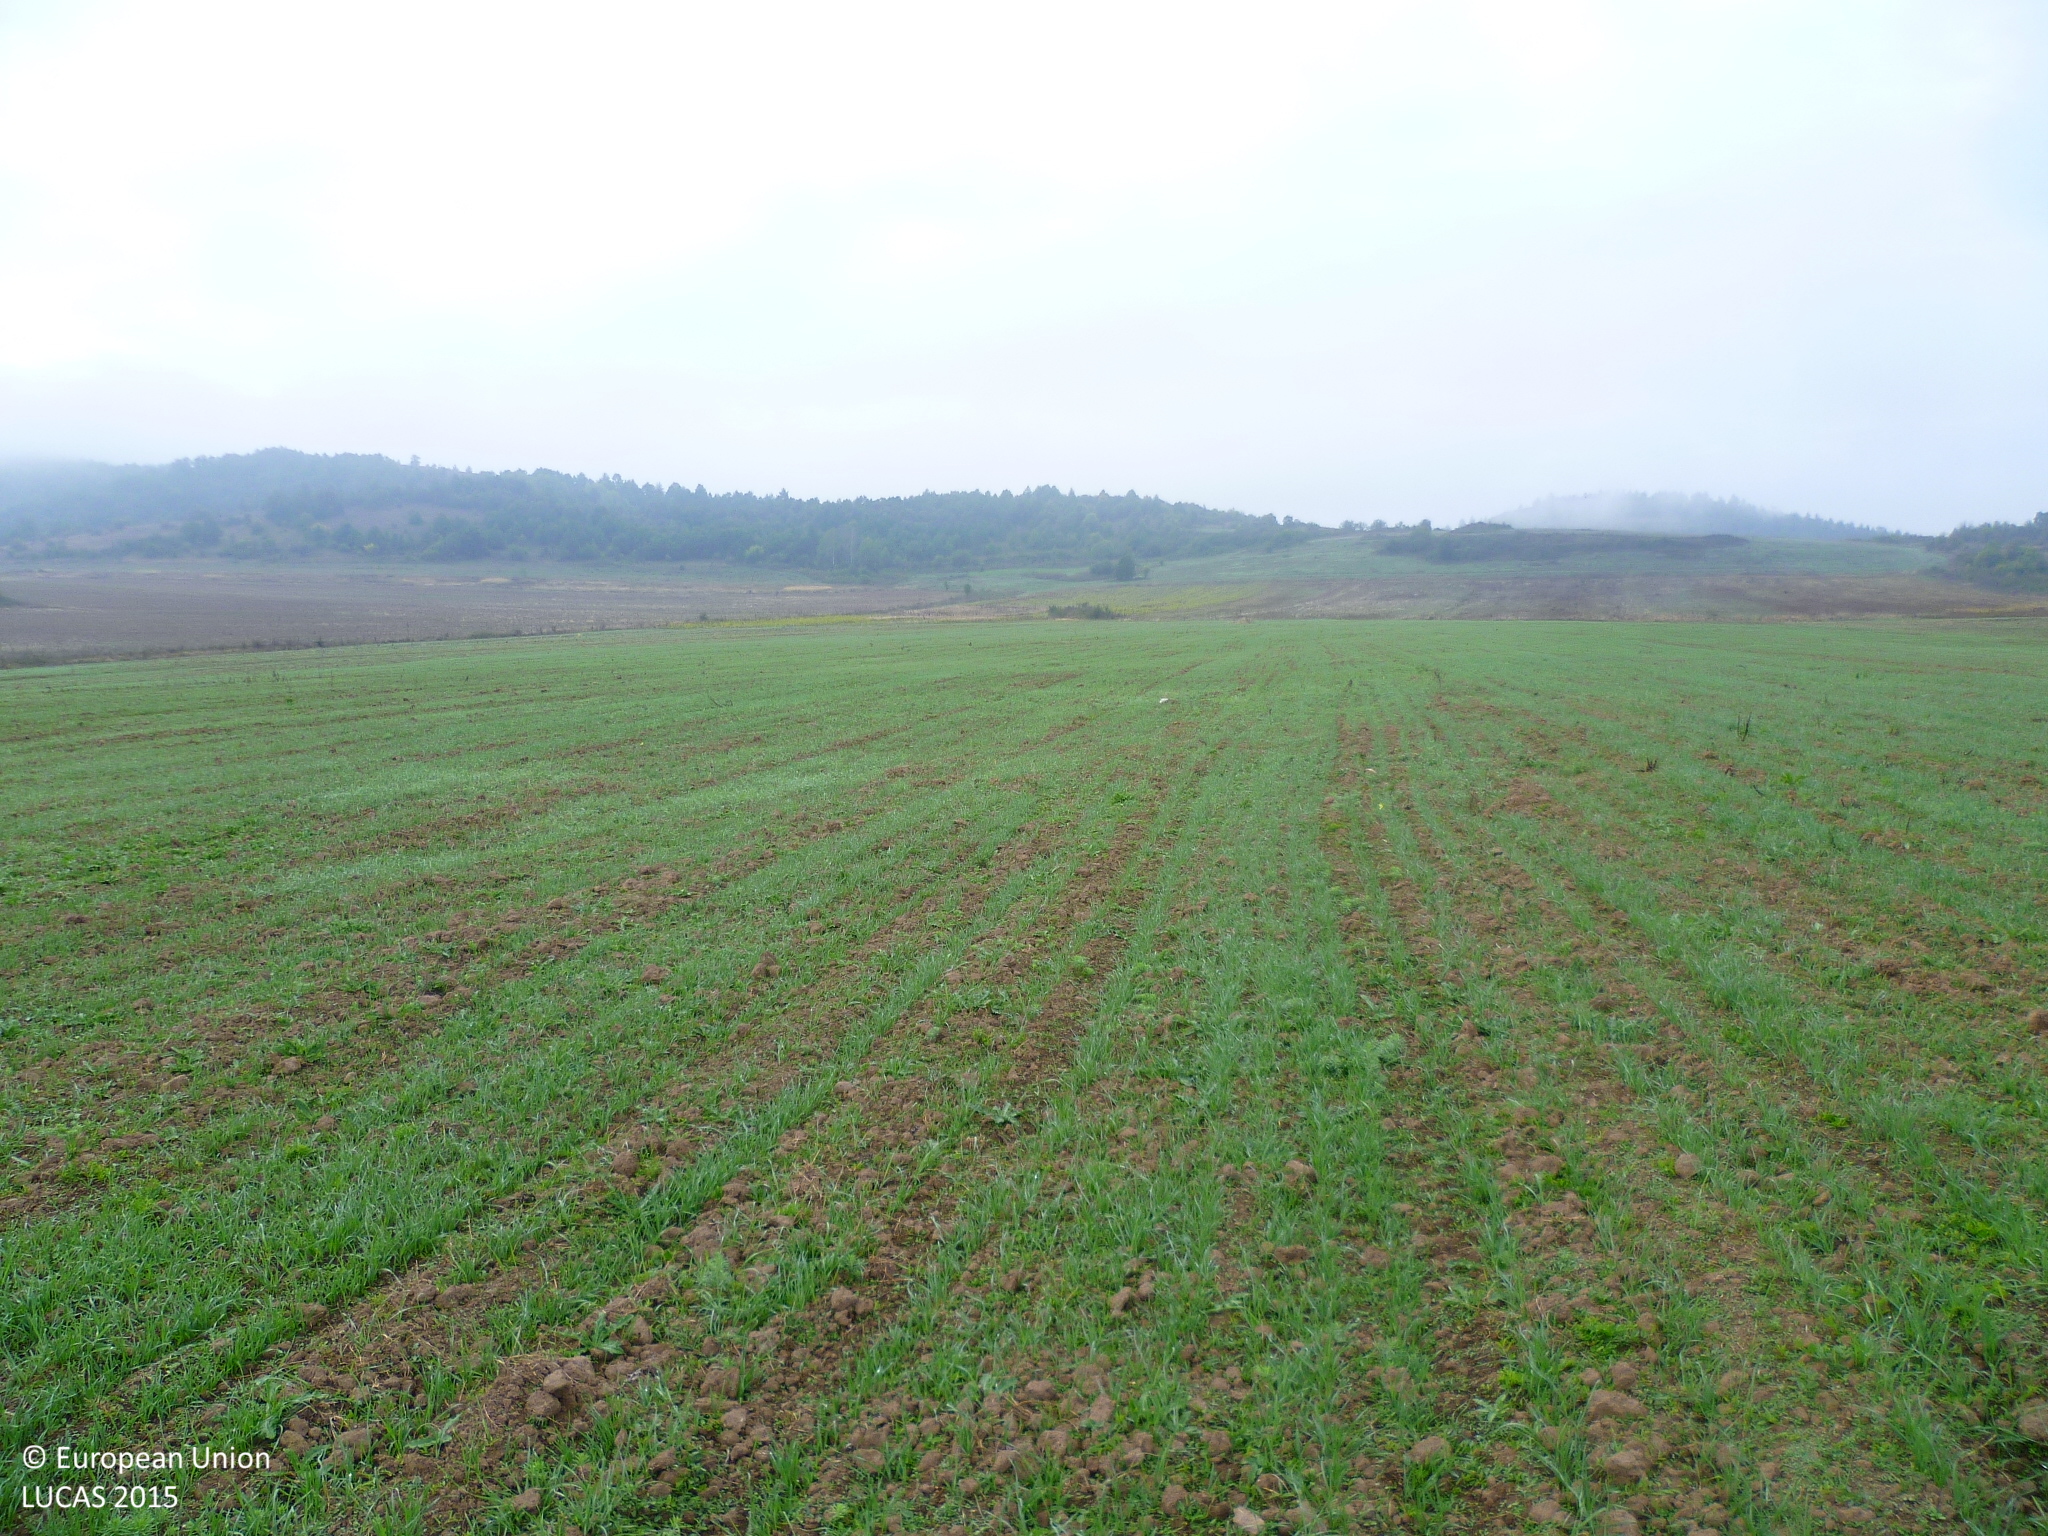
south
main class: Cropland
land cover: Common wheat
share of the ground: 25 - 50 %
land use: Agriculture (excluding fallow land and kitchen gardens)
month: October
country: BG
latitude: 42.8087
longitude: 22.6339
